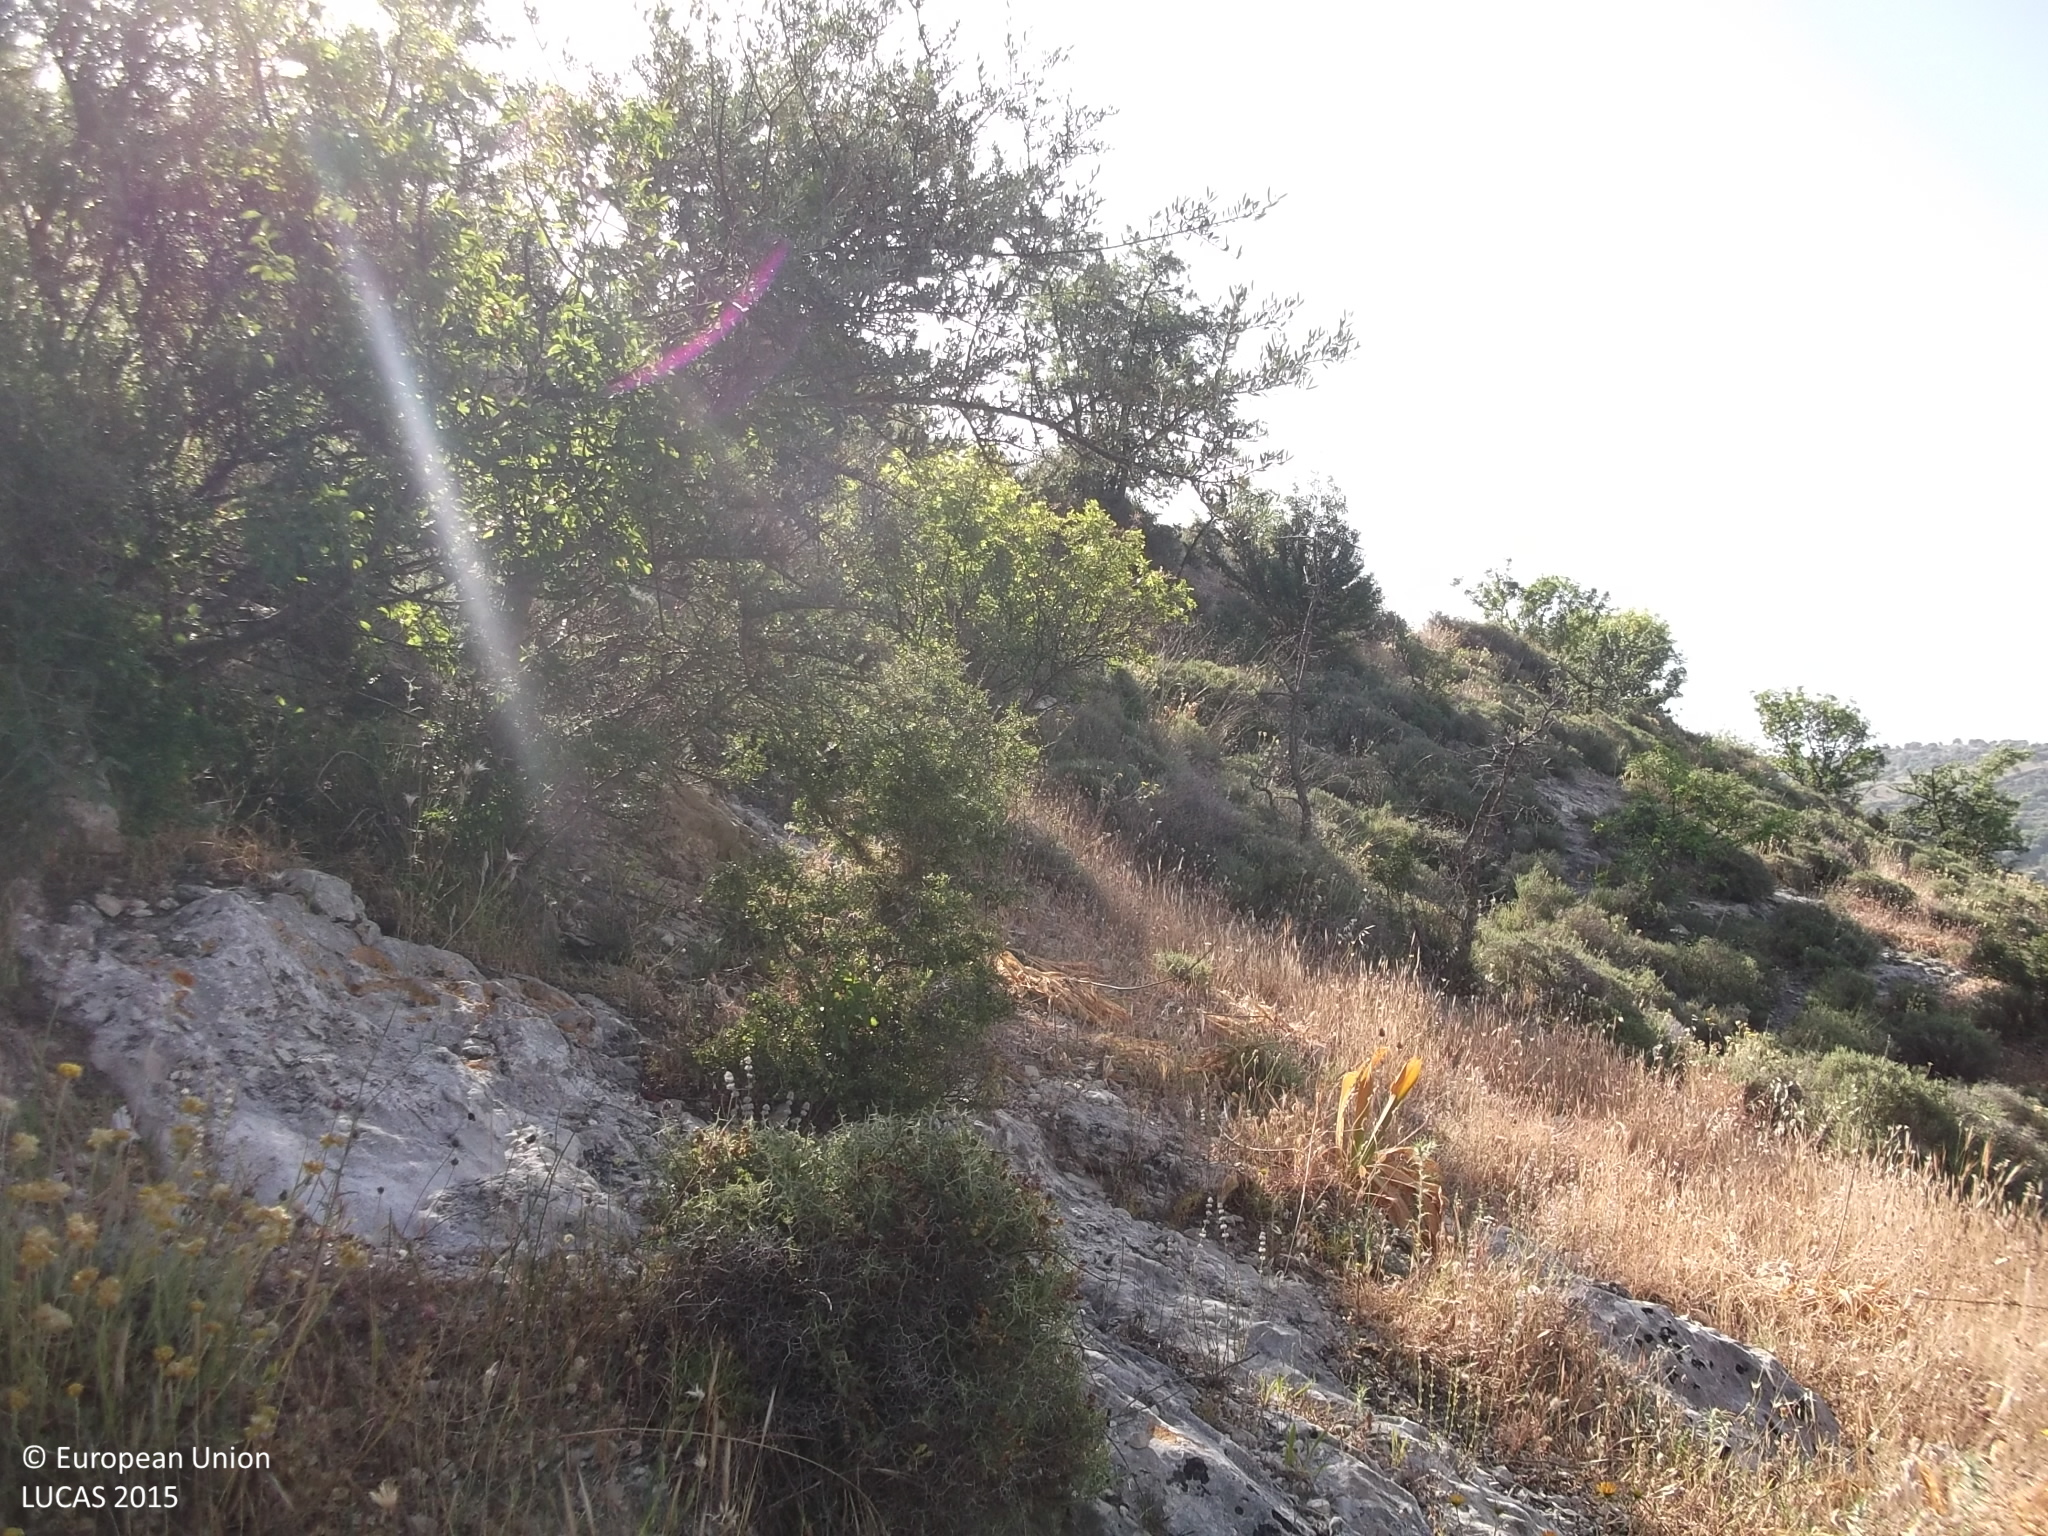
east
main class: Shrubland
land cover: Shrubland with sparse tree cover
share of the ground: 25 - 50 %
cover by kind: shrubs 45 %, herbaceous plants 30 %, consolidated bare surface 20 %, broadleaved forest trees 5 %
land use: Semi-natural and natural areas not in use
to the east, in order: Shrubland with sparse tree cover; Broadleaved woodland; Shrubland with sparse tree cover; Shrubland without tree cover; Broadleaved woodland; Shrubland with sparse tree cover
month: May
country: CY
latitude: 34.9008
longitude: 32.5779
